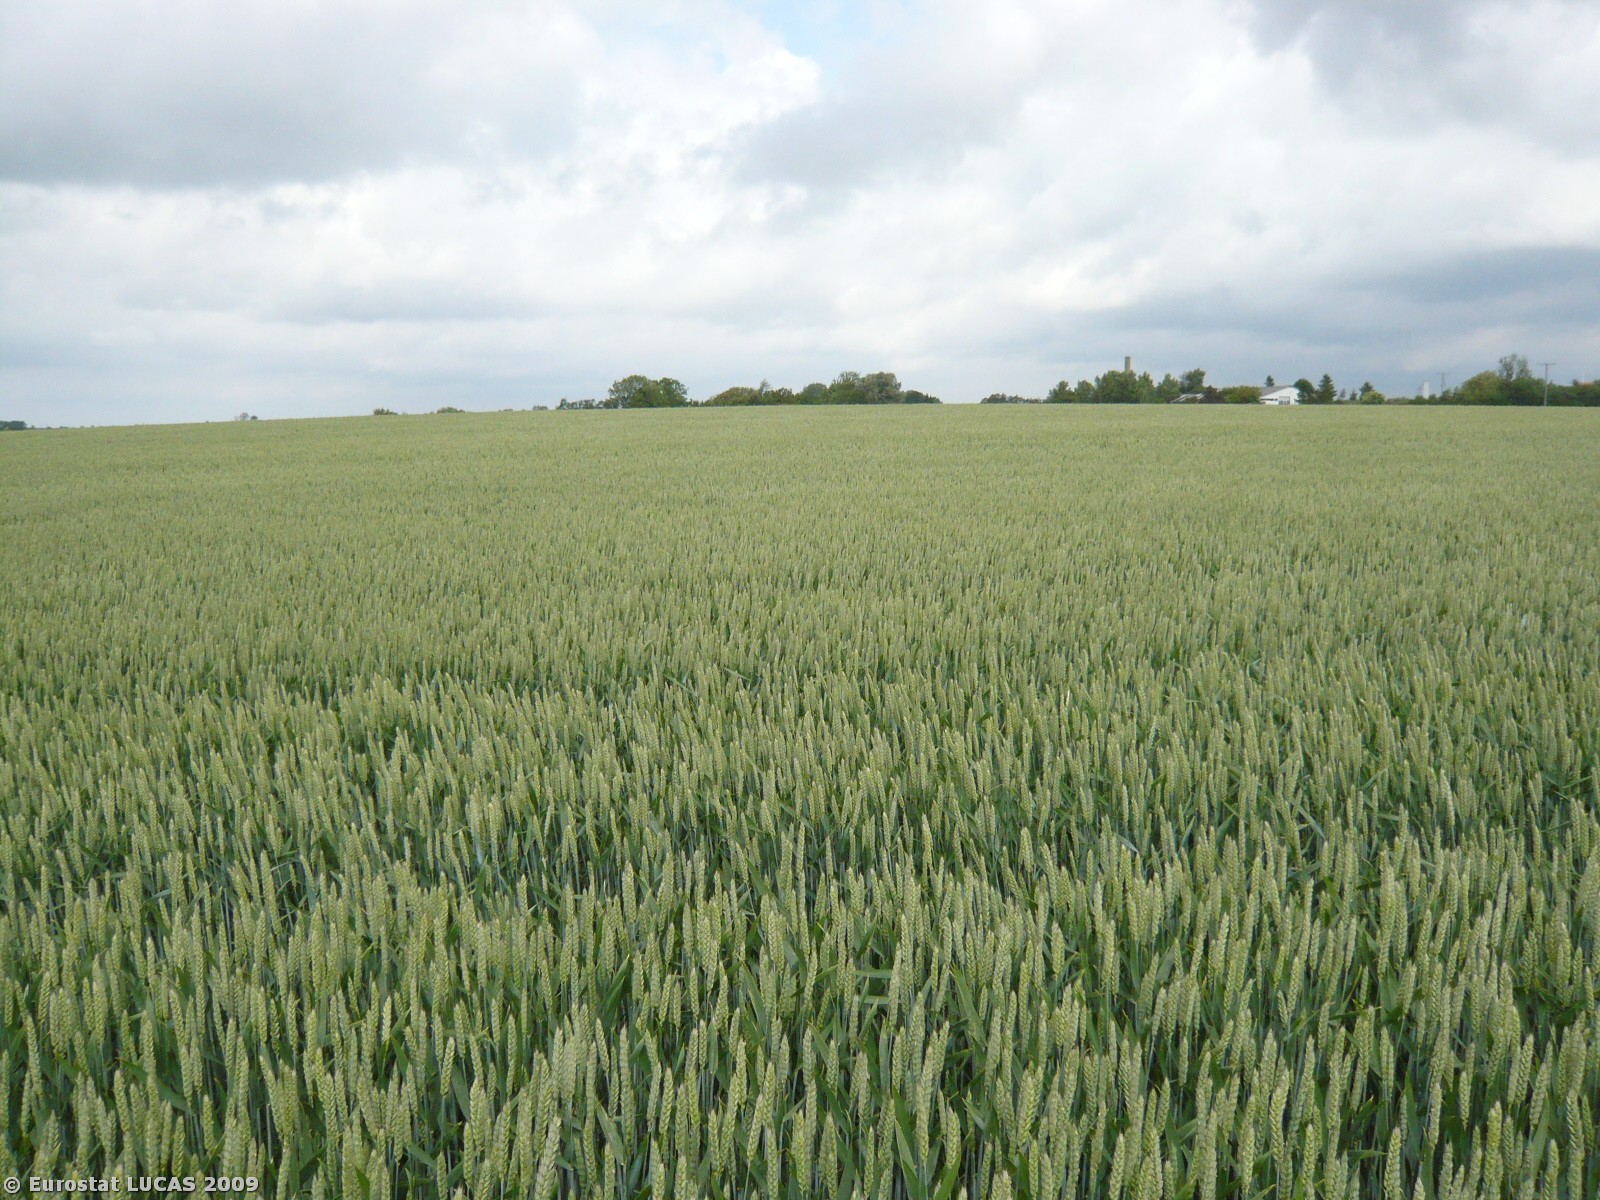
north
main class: Cropland
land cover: Common wheat
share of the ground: > 75 %
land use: Agriculture (excluding fallow land and kitchen gardens)
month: June
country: DK
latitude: 54.8983
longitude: 11.8232
